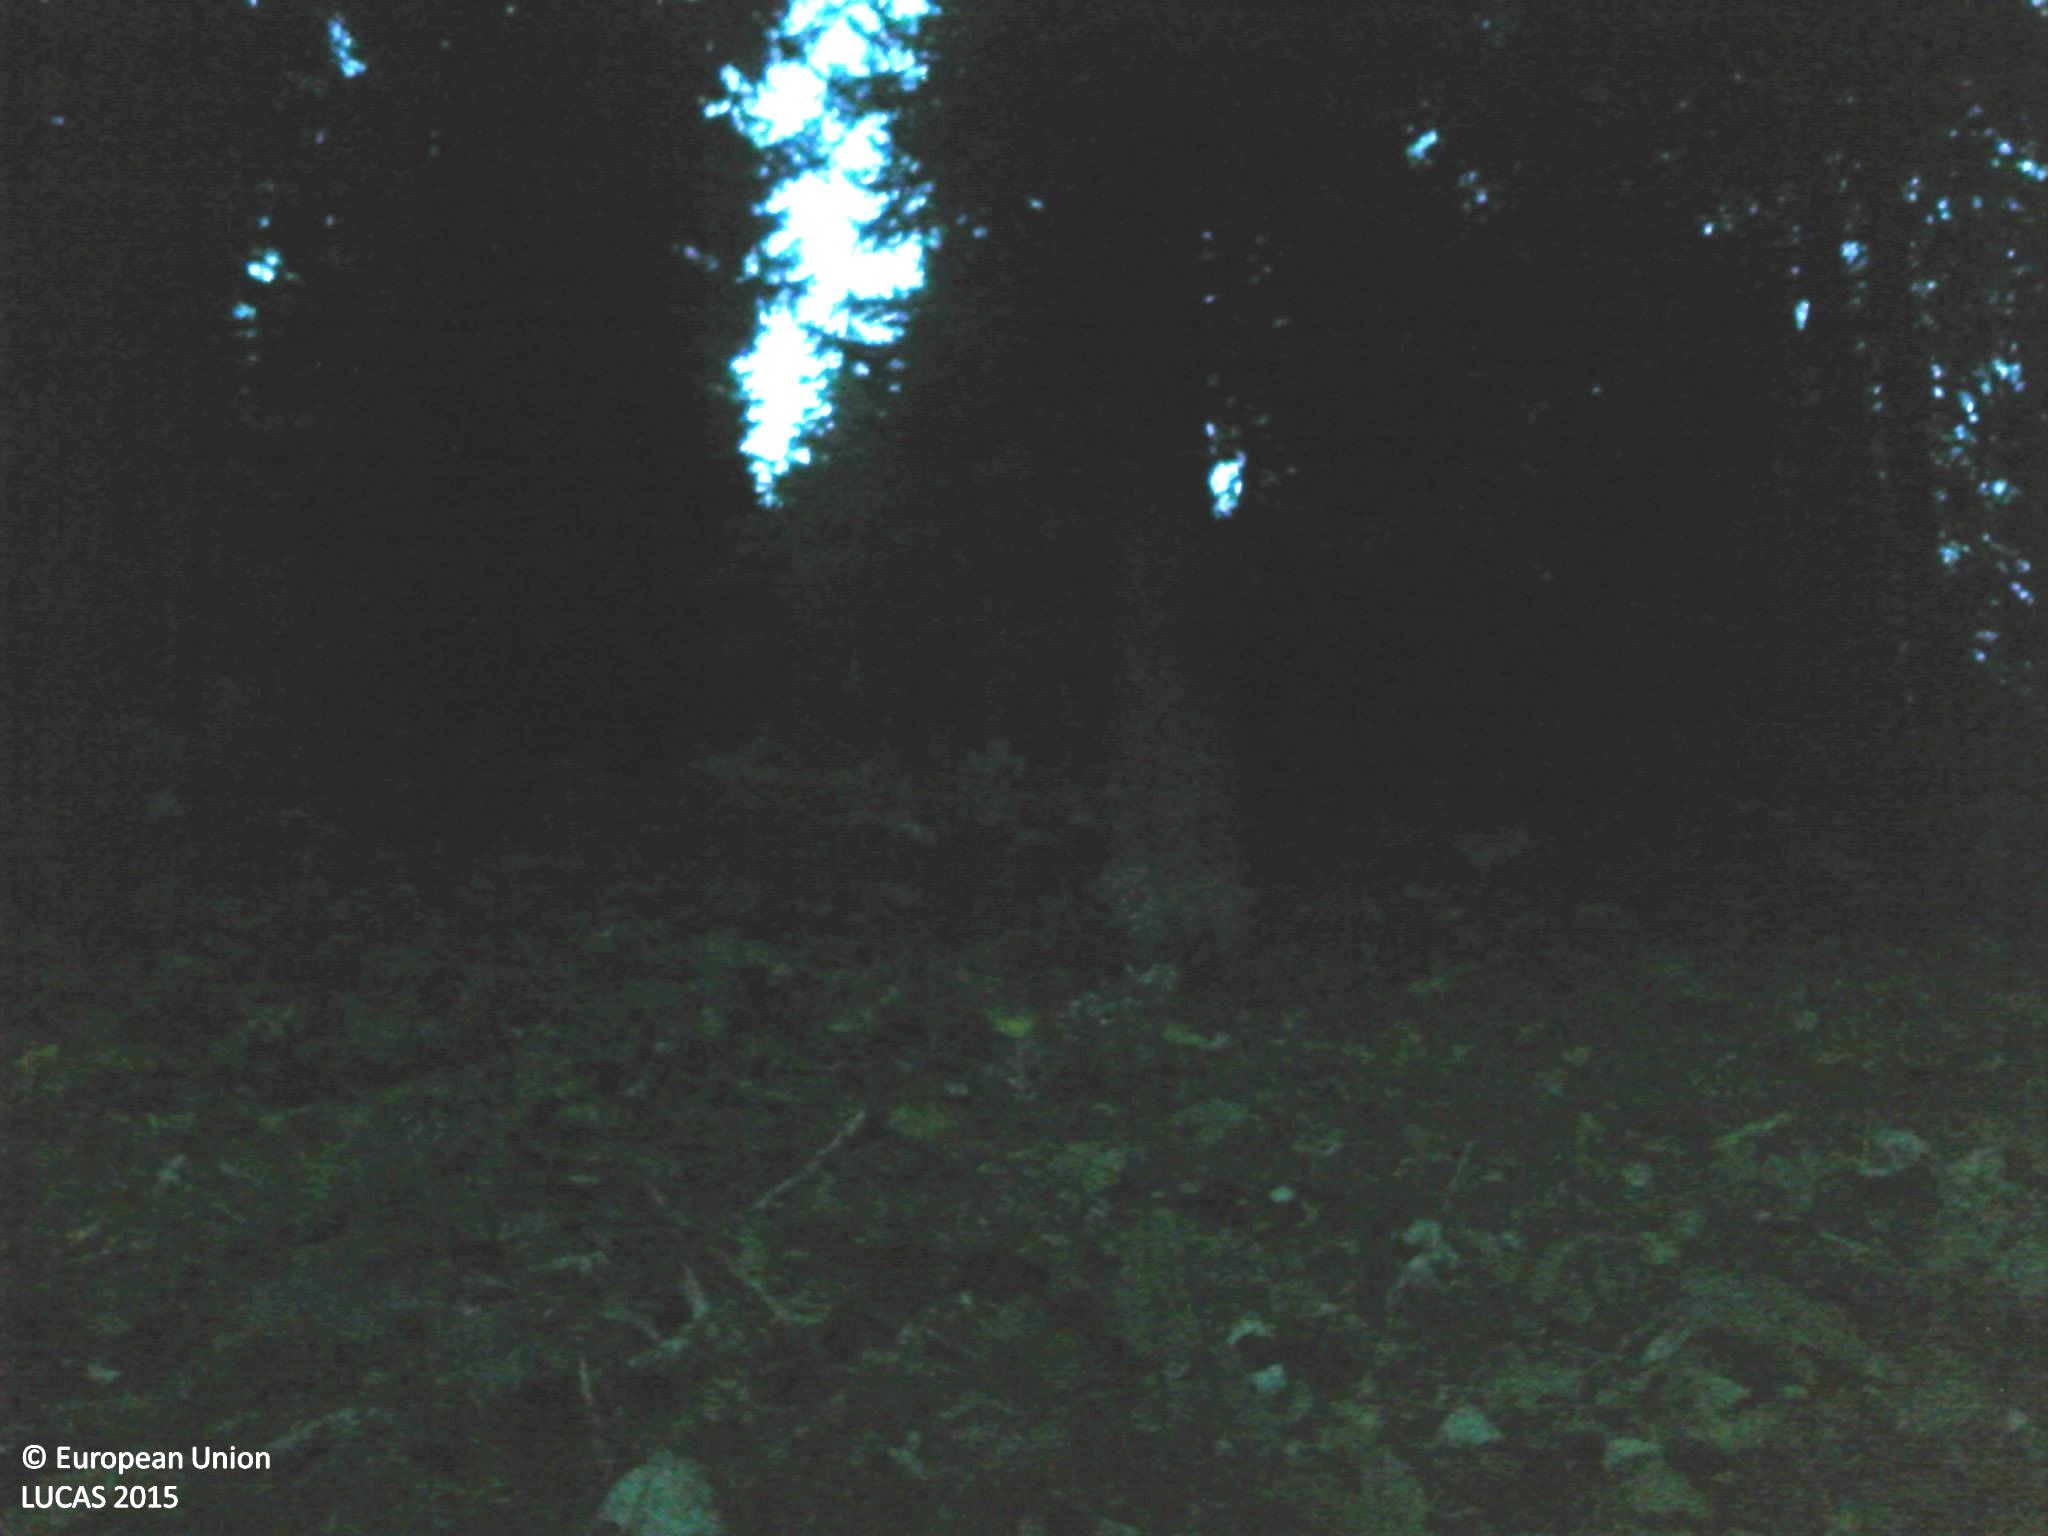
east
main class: Woodland
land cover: Spruce dominated mixed woodland
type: alpine coniferous forest
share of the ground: > 75 %
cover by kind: coniferous forest trees 60 %, broadleaved forest trees 40 %
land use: Sport
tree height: > 5 m
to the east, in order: Spruce dominated mixed woodland; Paved roads, cycling and walking lanes; Spruce dominated mixed woodland
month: July
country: FR
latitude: 45.1957
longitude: 5.5883
